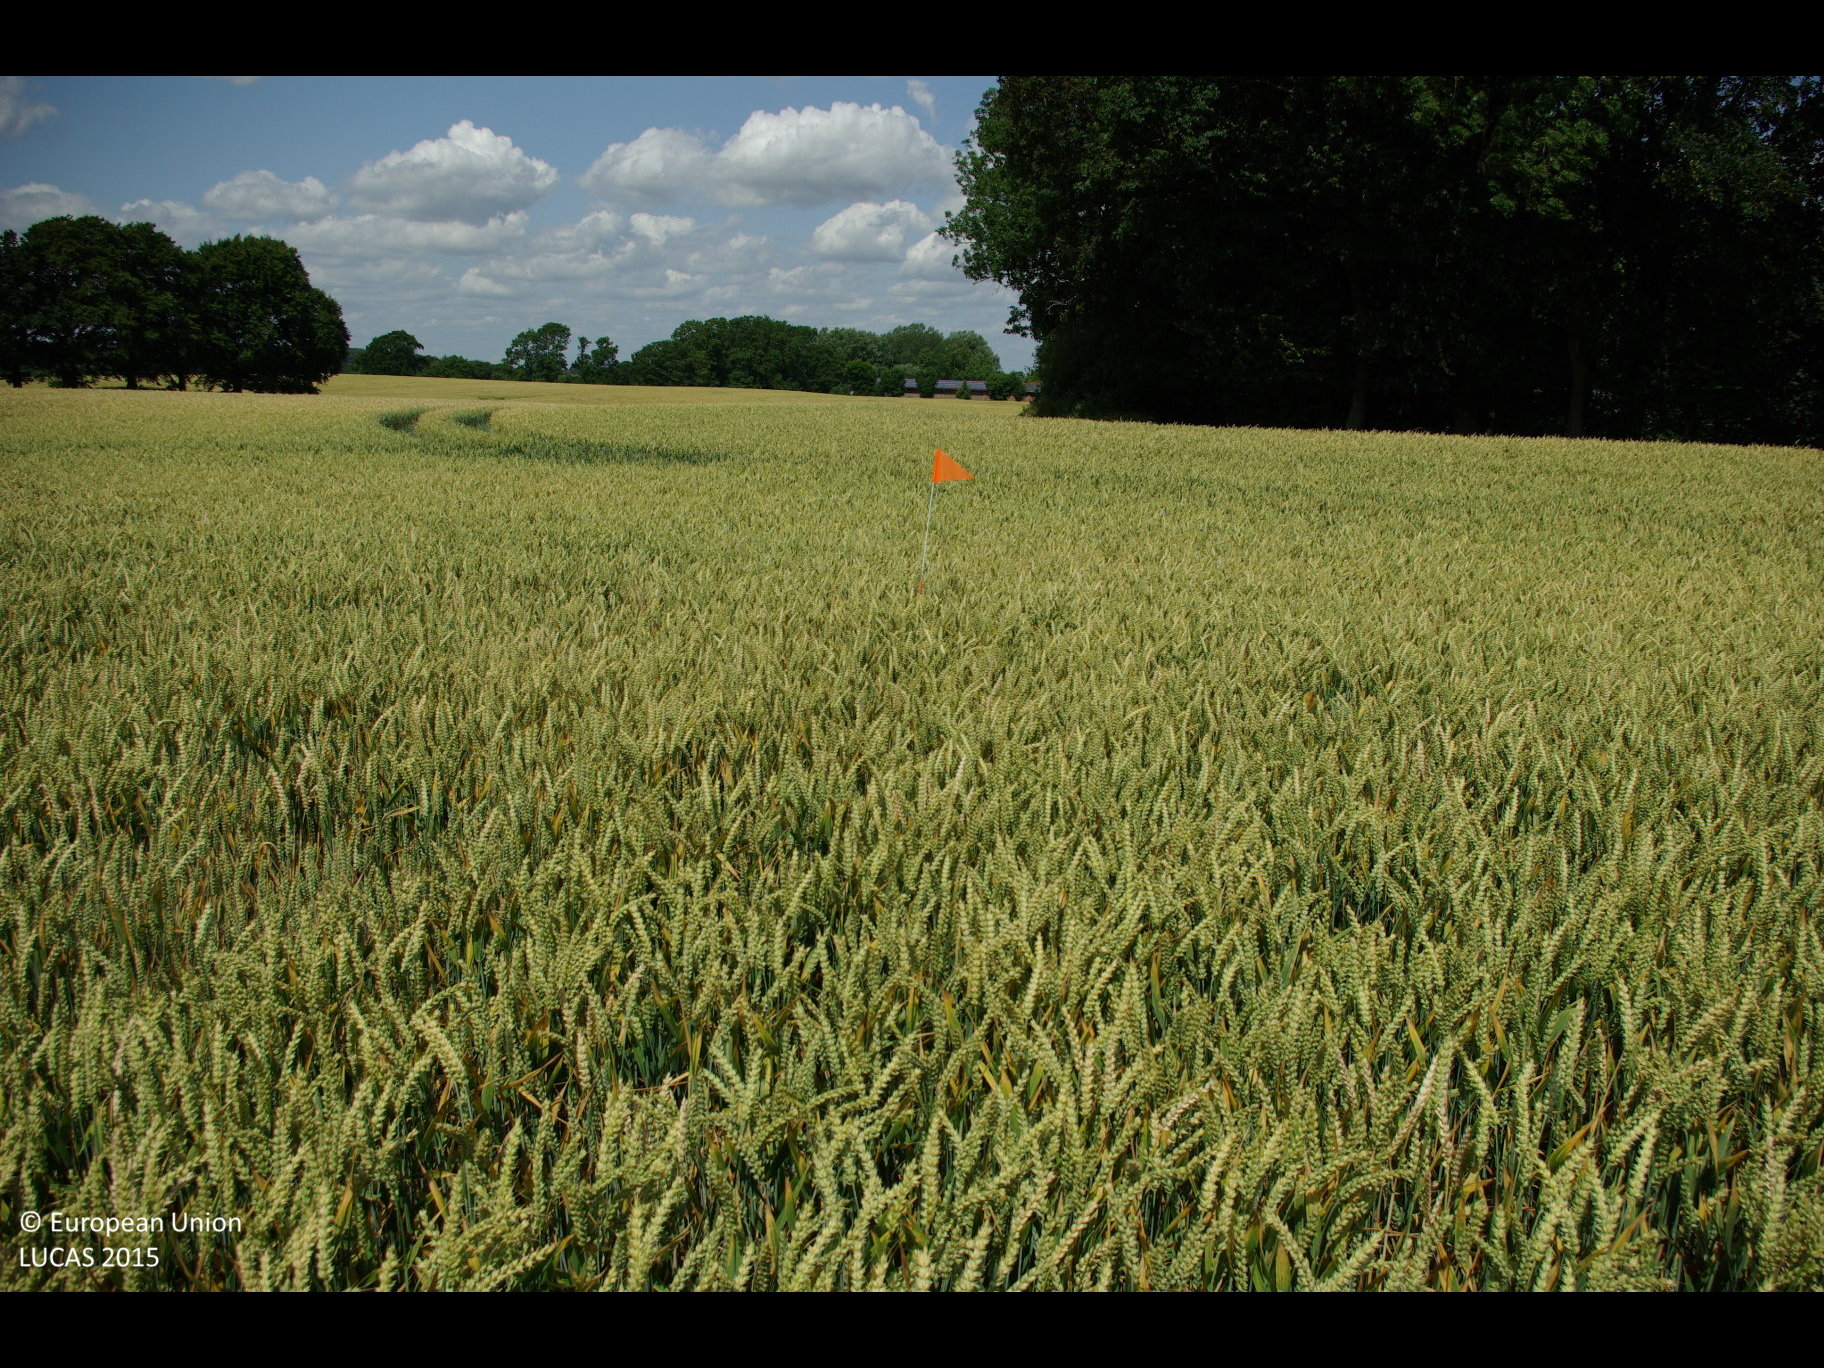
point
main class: Cropland
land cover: Common wheat
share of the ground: > 75 %
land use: Agriculture (excluding fallow land and kitchen gardens)
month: July
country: DE
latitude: 54.5341
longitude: 9.9537
